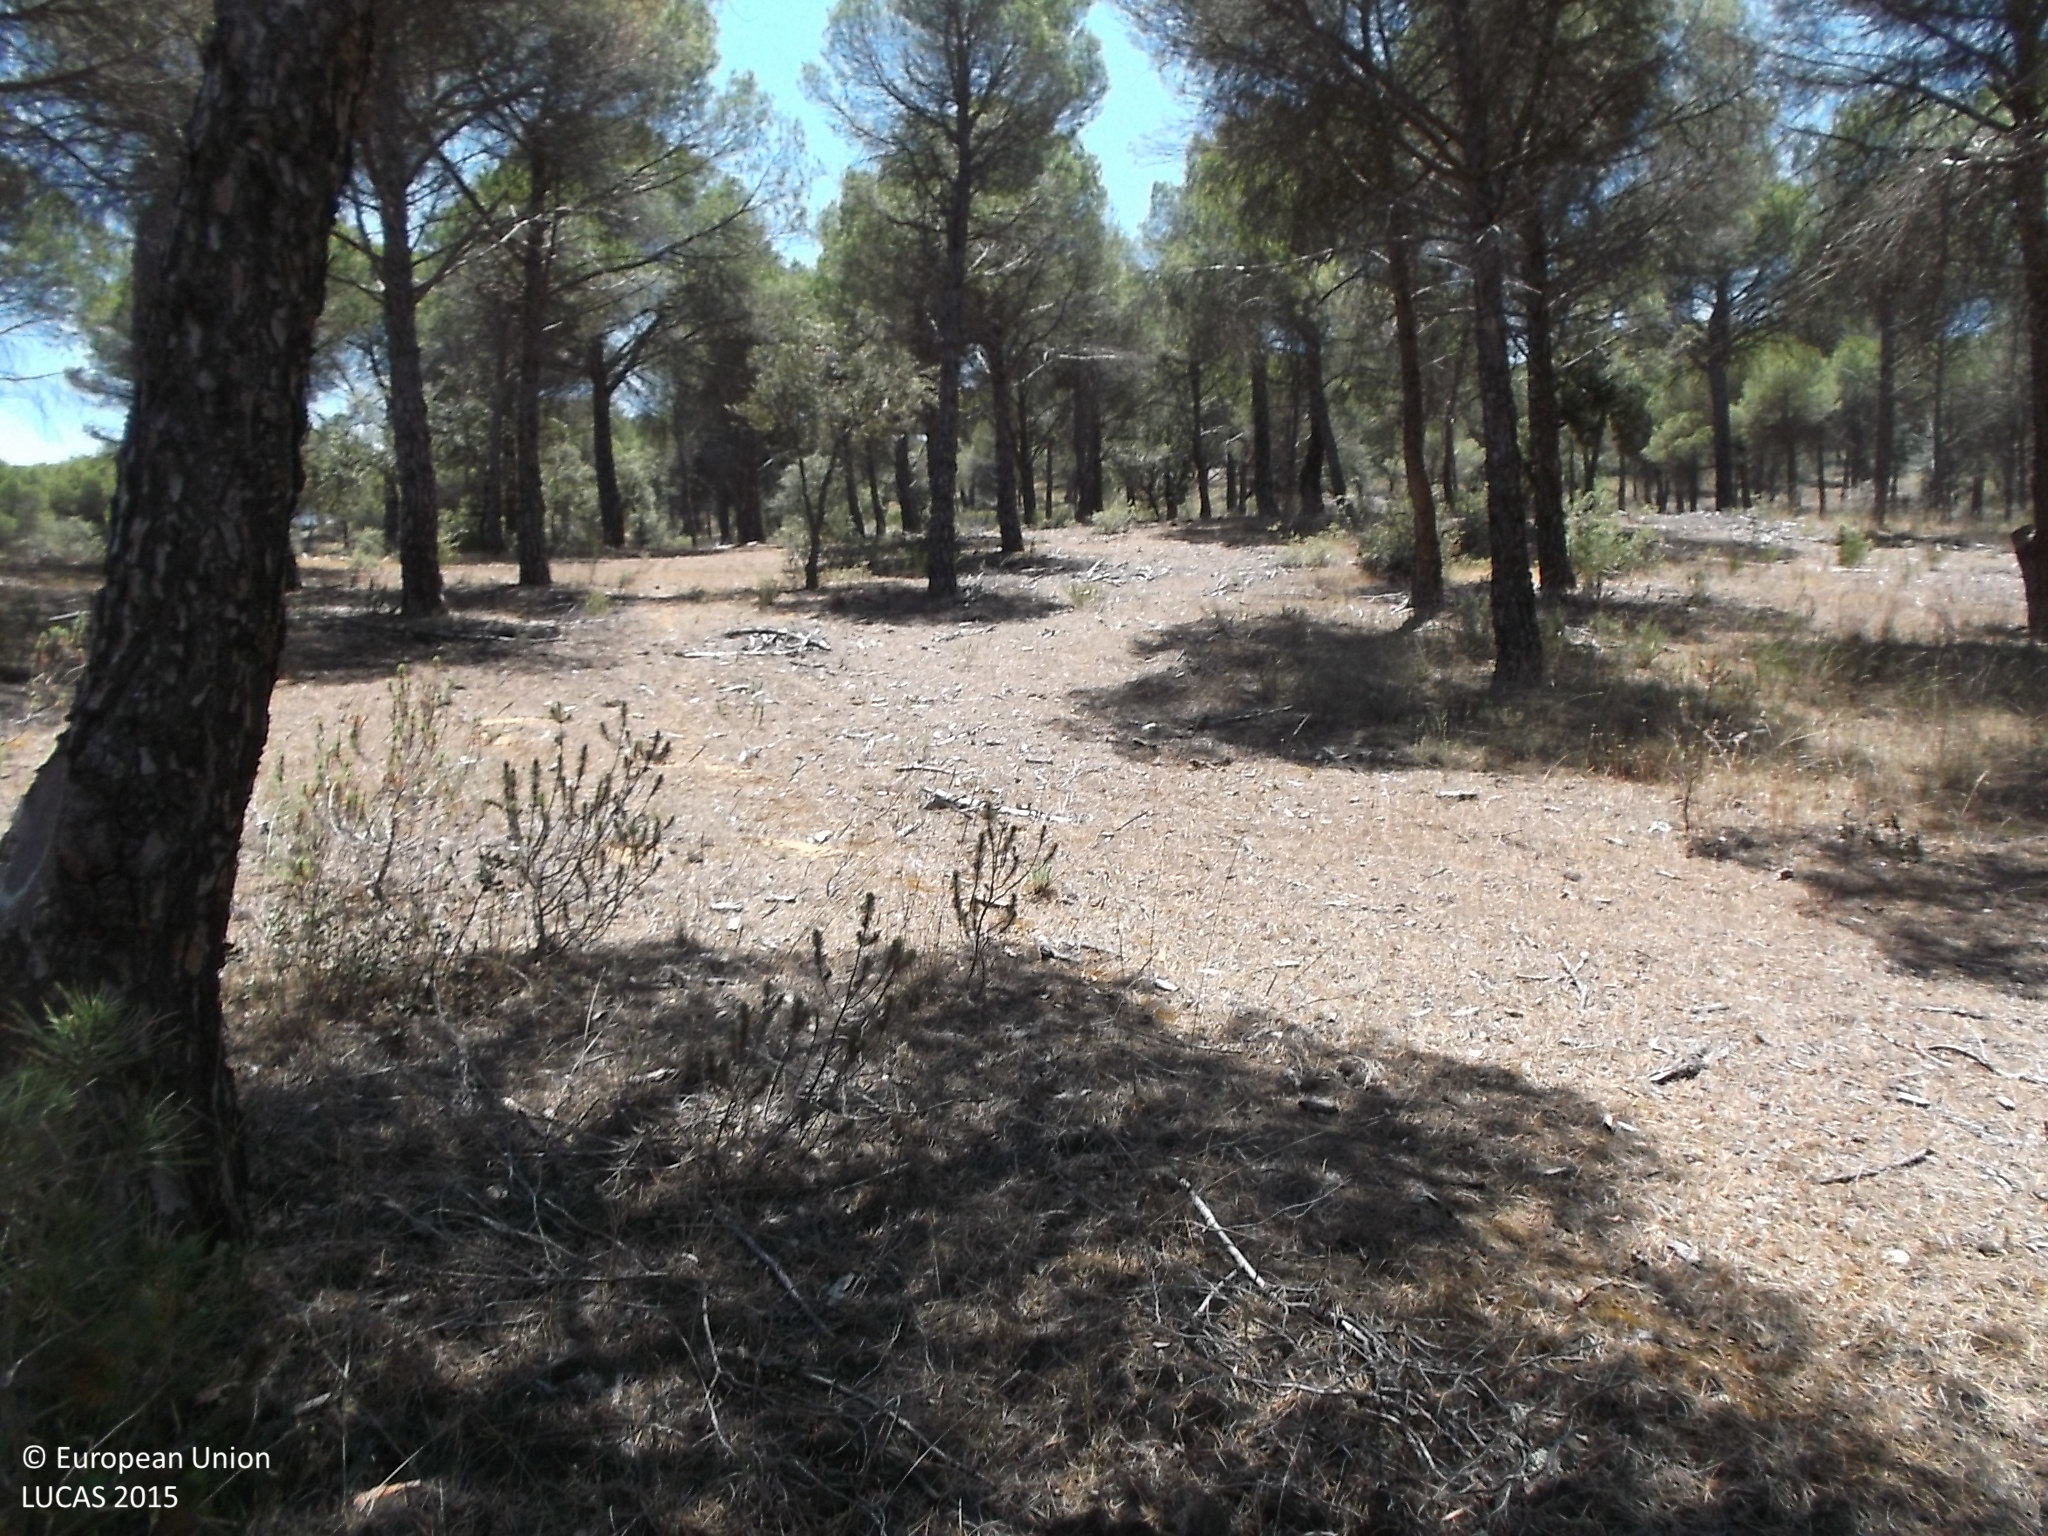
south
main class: Woodland
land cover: Pine dominated mixed woodland
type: coniferous forest of the mediterranean region
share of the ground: > 75 %
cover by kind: coniferous forest trees 50 %, broadleaved forest trees 25 %, herbaceous plants 25 %
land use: Forestry
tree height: > 5 m
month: June
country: ES
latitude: 41.4368
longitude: -5.4829
